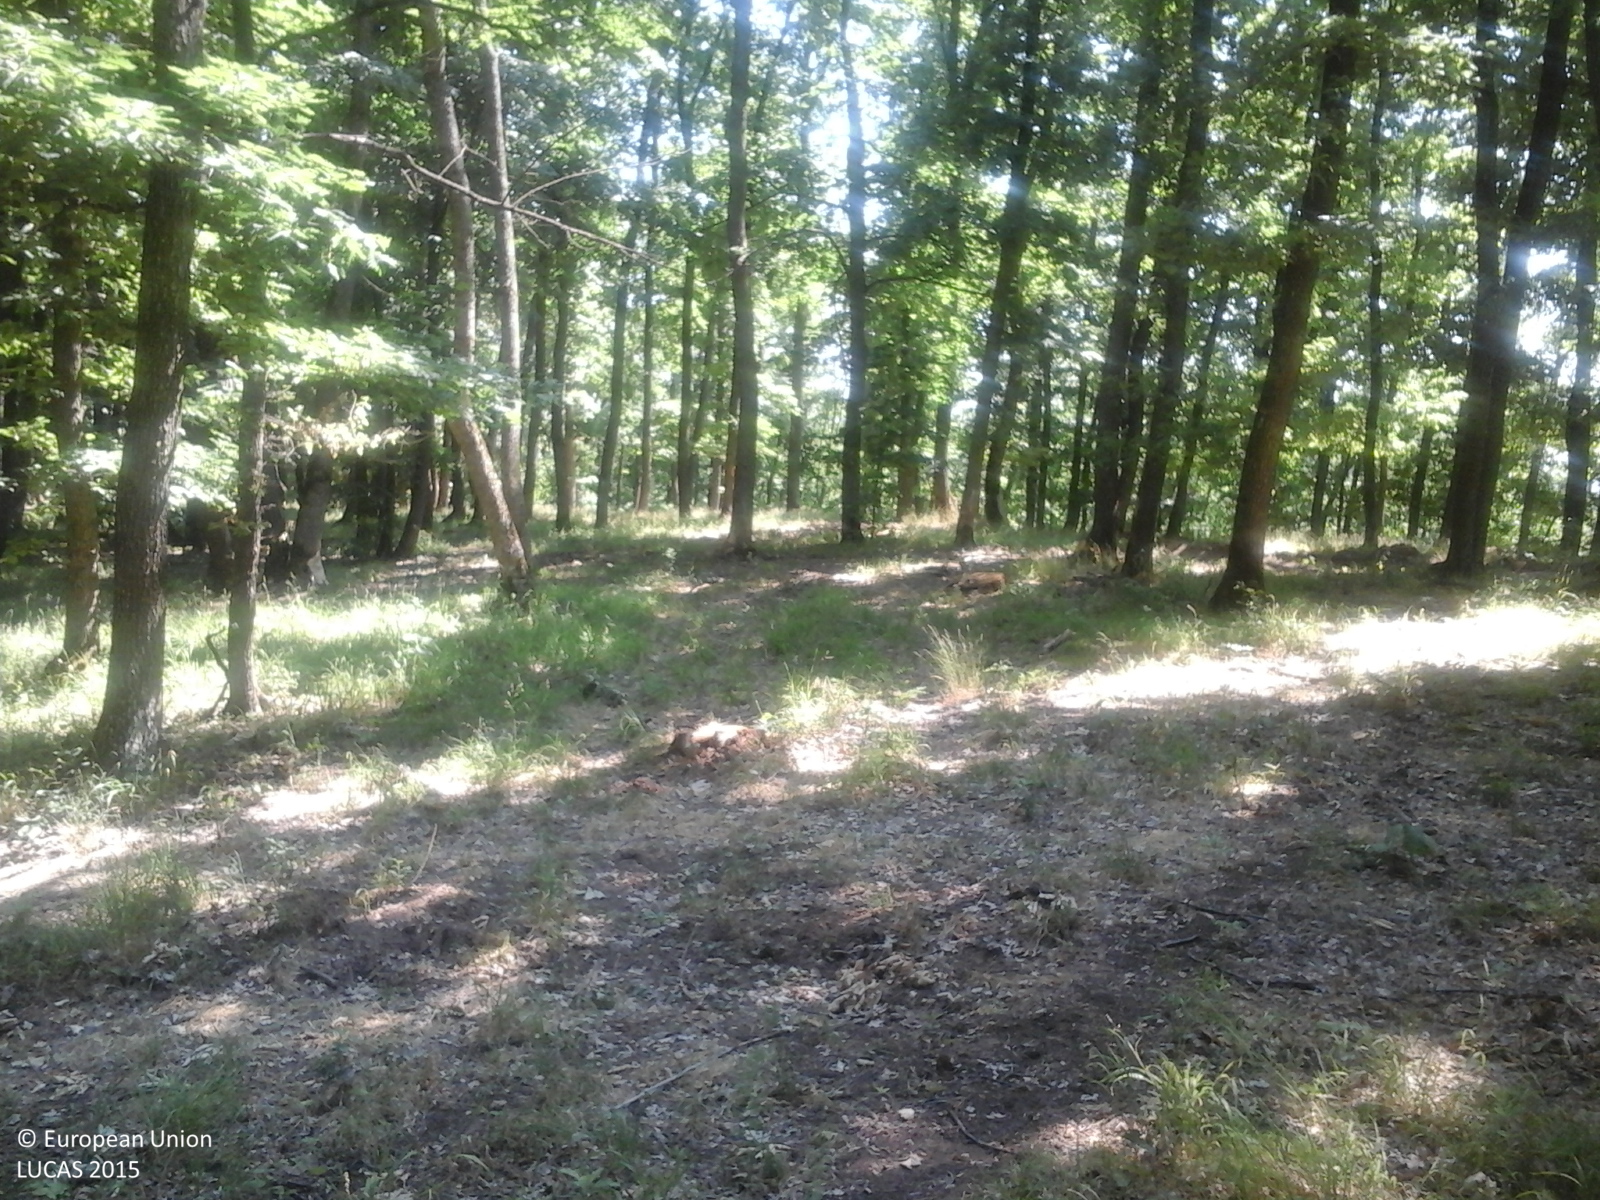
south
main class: Woodland
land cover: Broadleaved woodland
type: beech forest
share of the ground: > 75 %
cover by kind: broadleaved forest trees 85 %, herbaceous plants 15 %
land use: Forestry
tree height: > 5 m
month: June
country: RO
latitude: 46.8401
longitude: 27.8656
